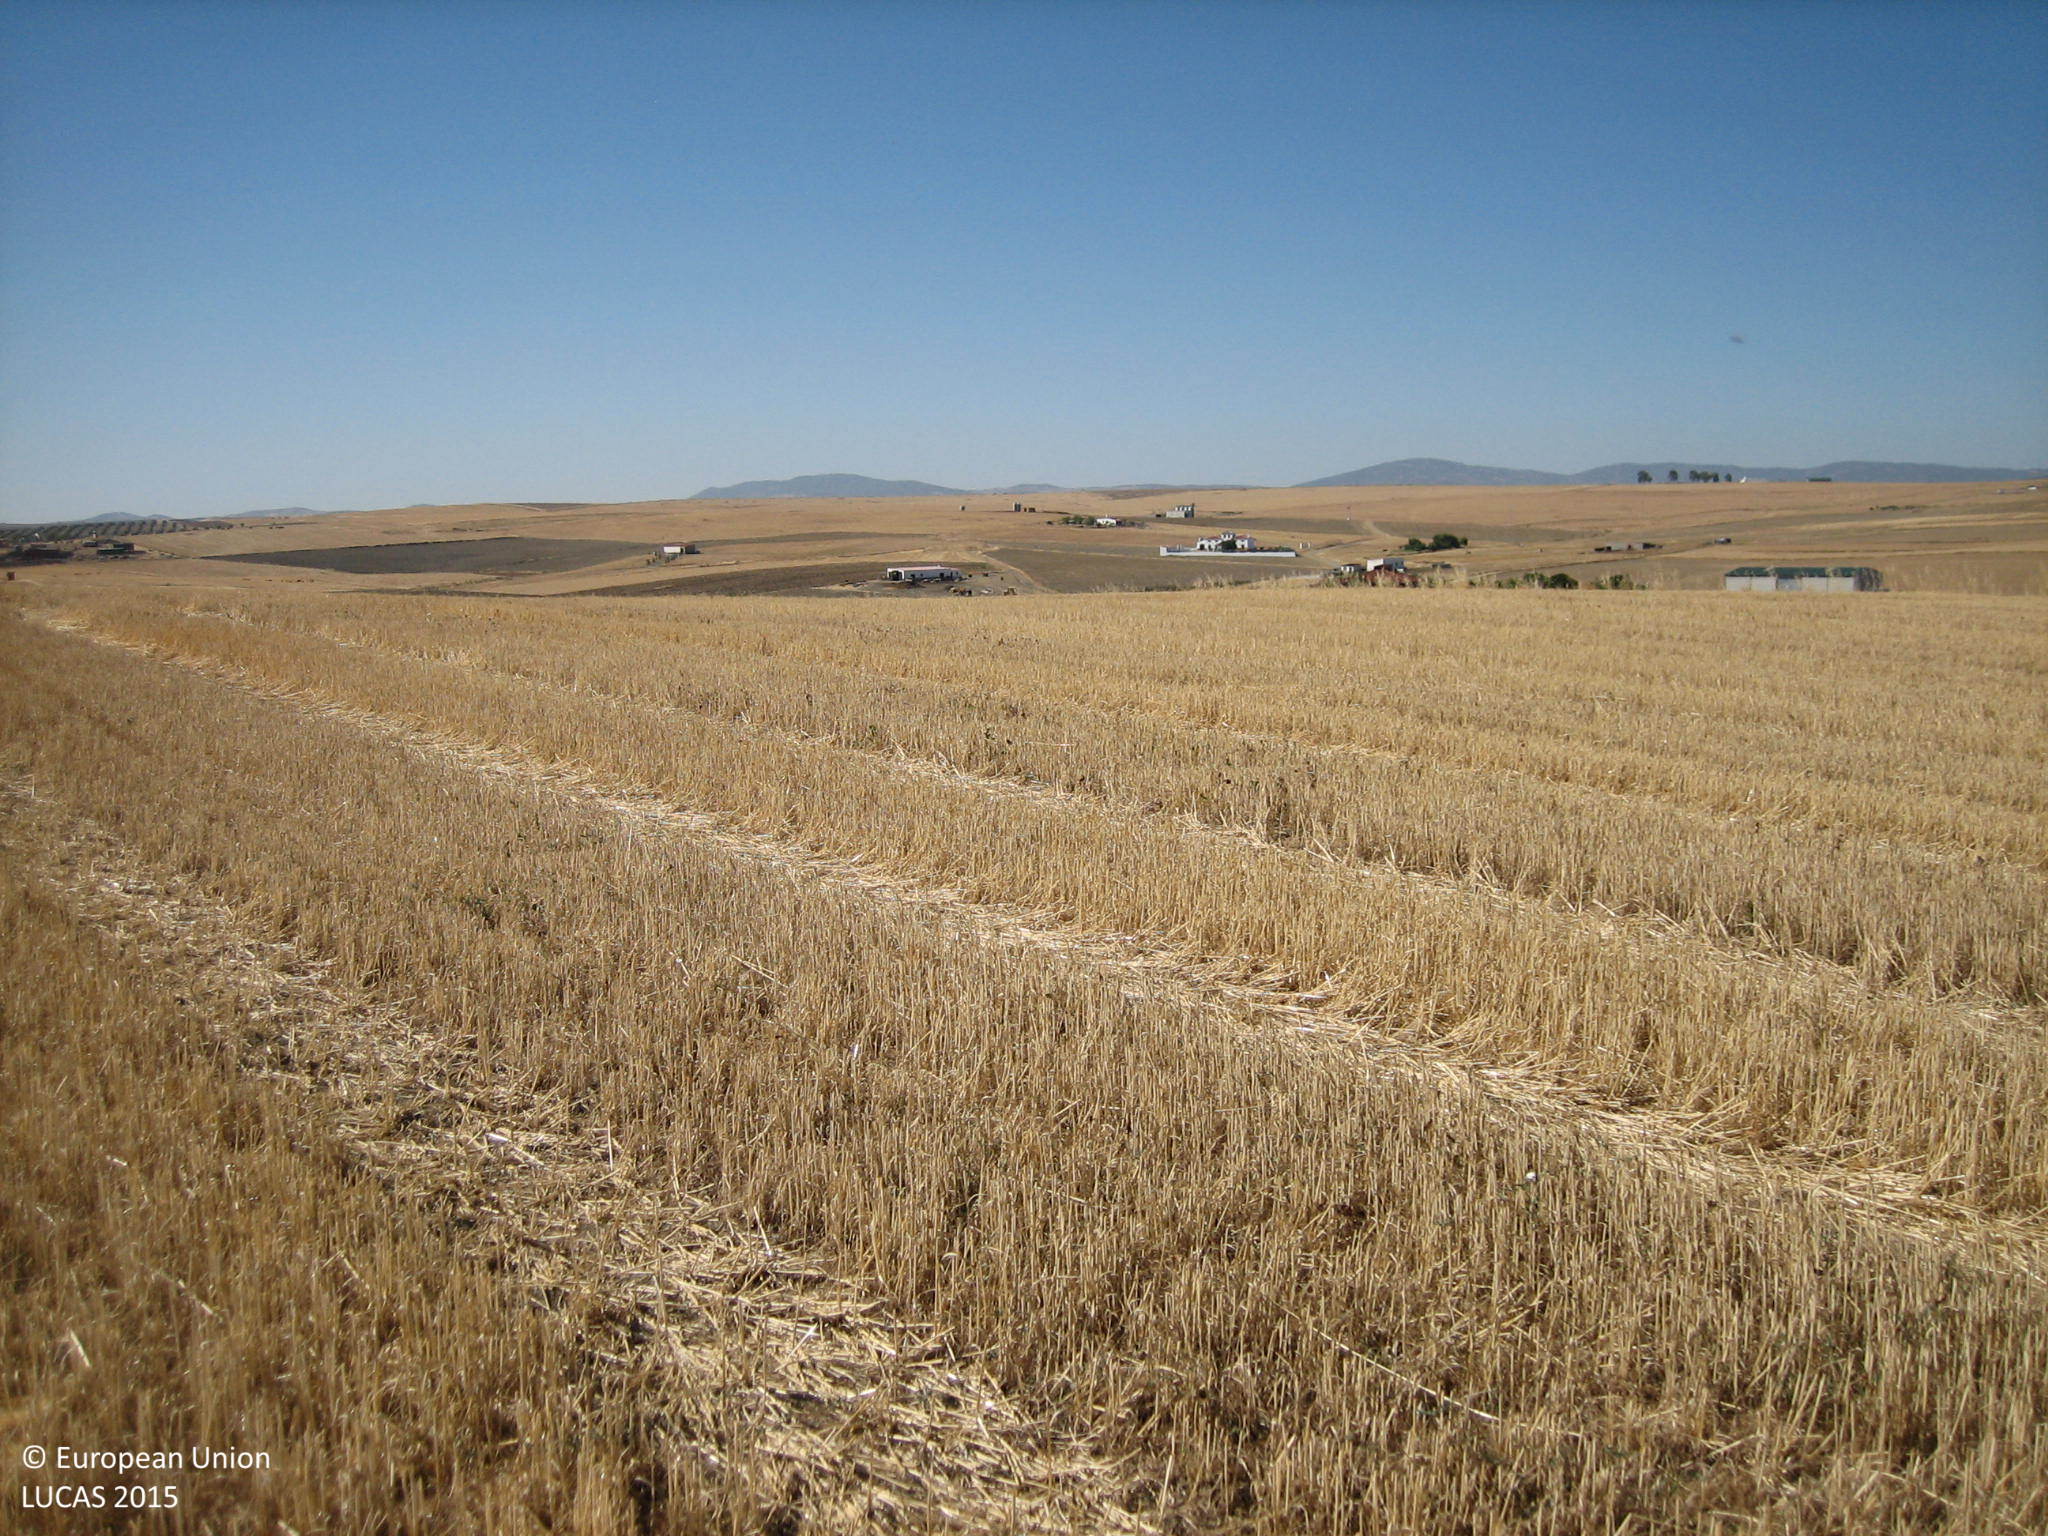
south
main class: Cropland
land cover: Common wheat
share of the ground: < 10 %
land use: Agriculture (excluding fallow land and kitchen gardens)
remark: Harvested field
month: July
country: ES
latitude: 38.2304
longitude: -6.3008
